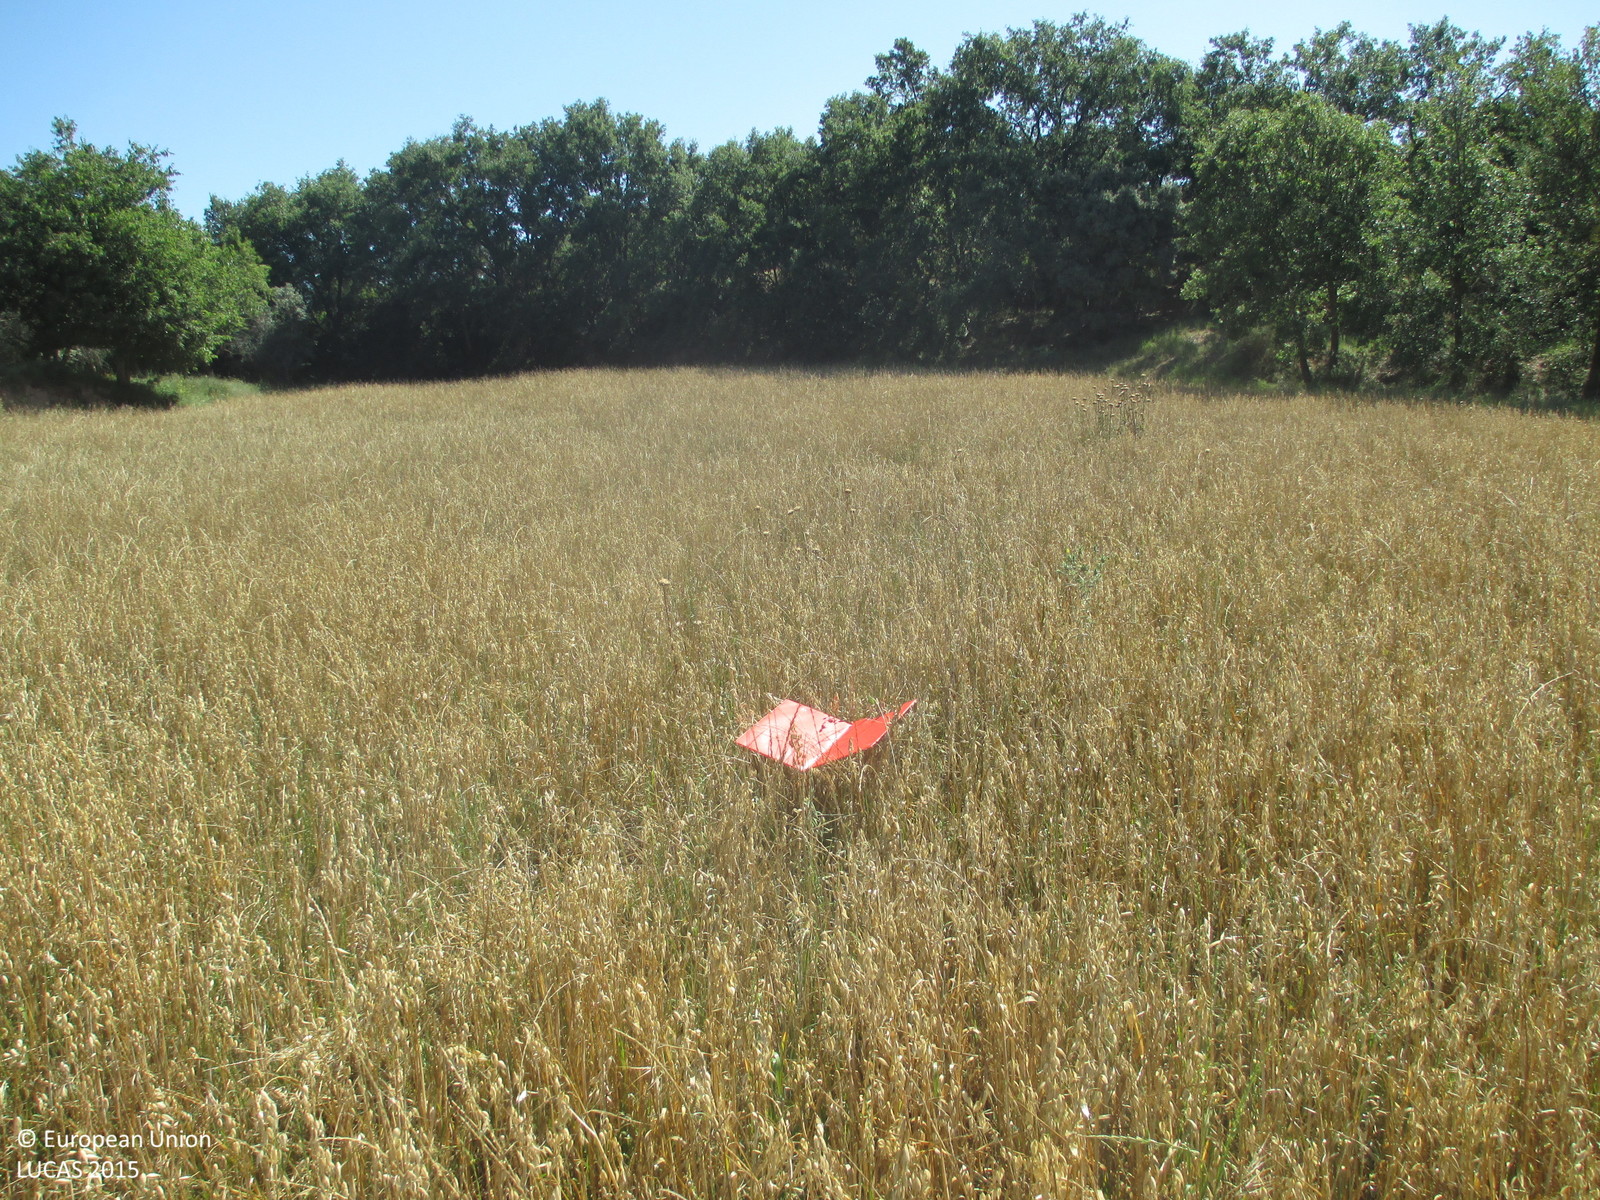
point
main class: Cropland
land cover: Mixed cereals for fodder
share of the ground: > 75 %
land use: Agriculture (excluding fallow land and kitchen gardens)
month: June
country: ES
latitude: 42.1730
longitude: -0.0317
